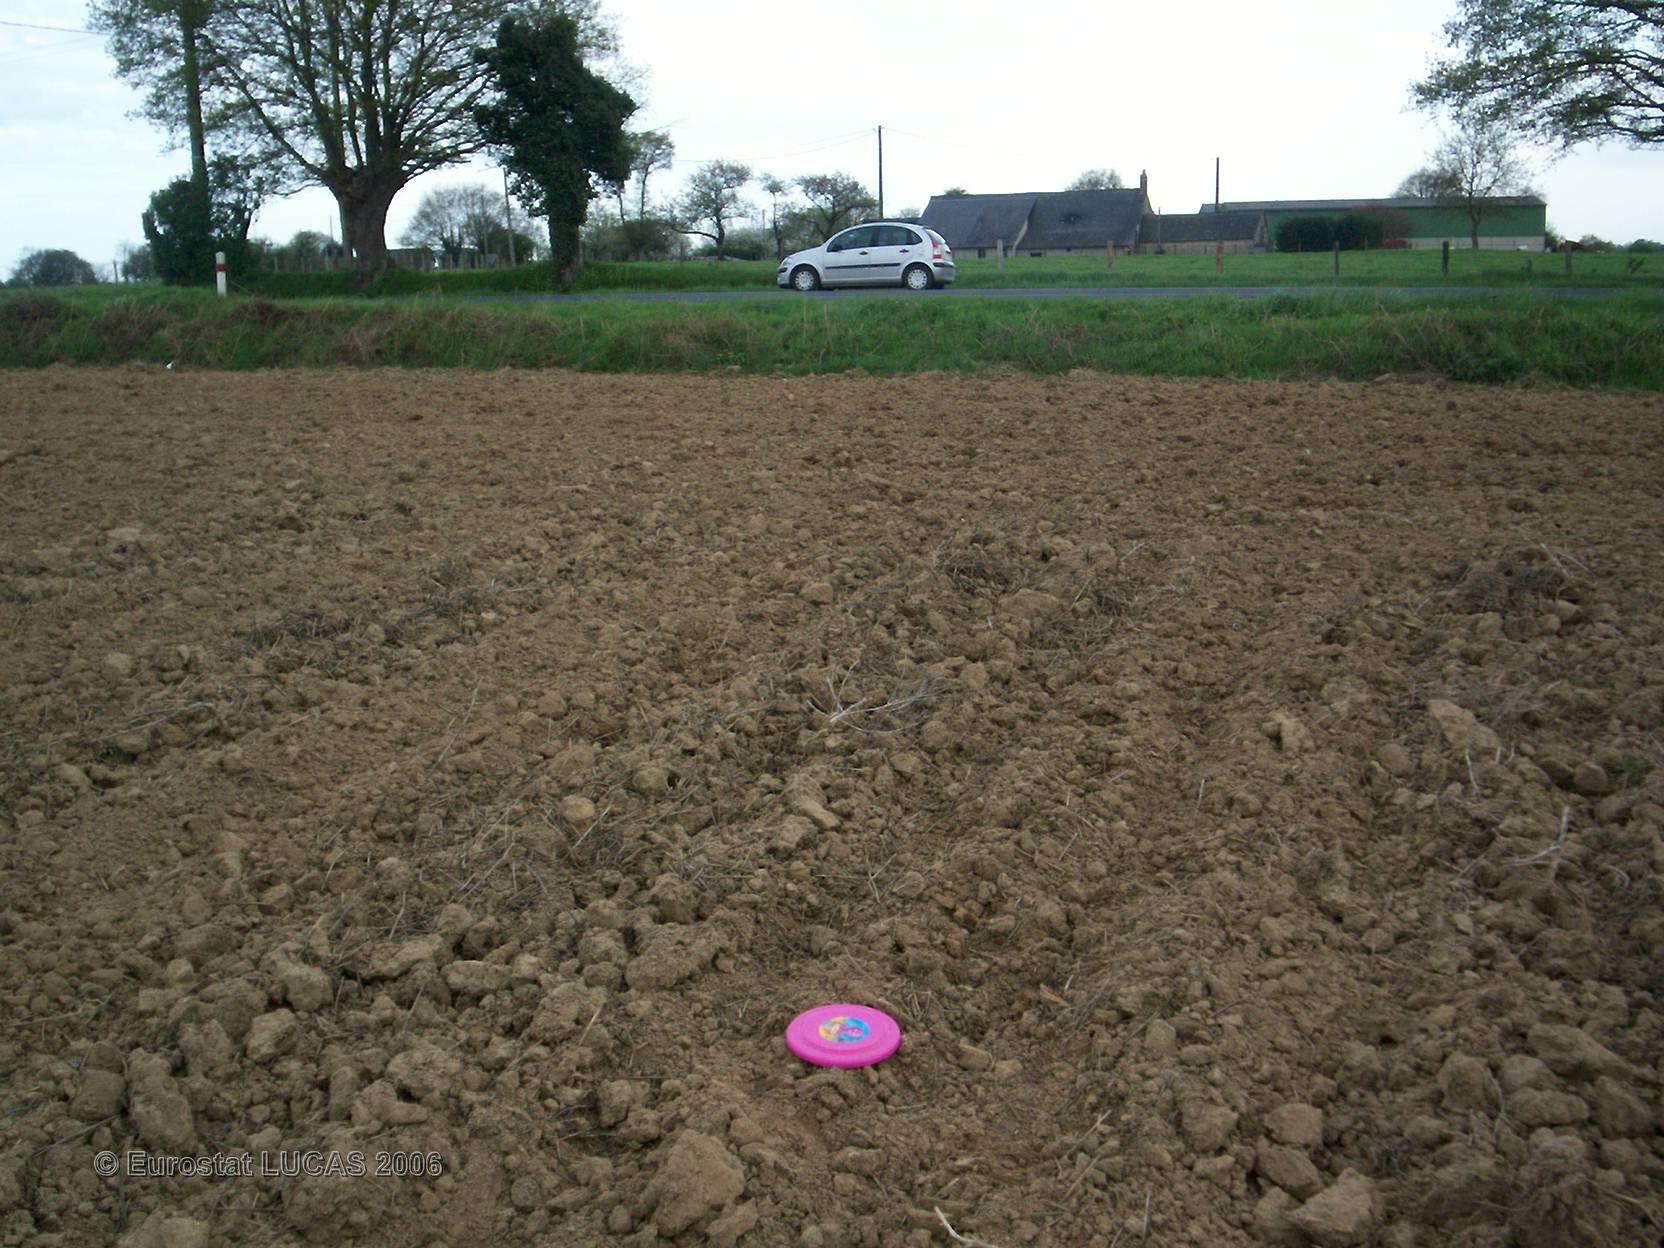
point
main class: Cropland
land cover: Maize
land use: Agriculture (excluding fallow land and kitchen gardens)
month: May
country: FR
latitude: 48.0206
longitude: -0.2067
